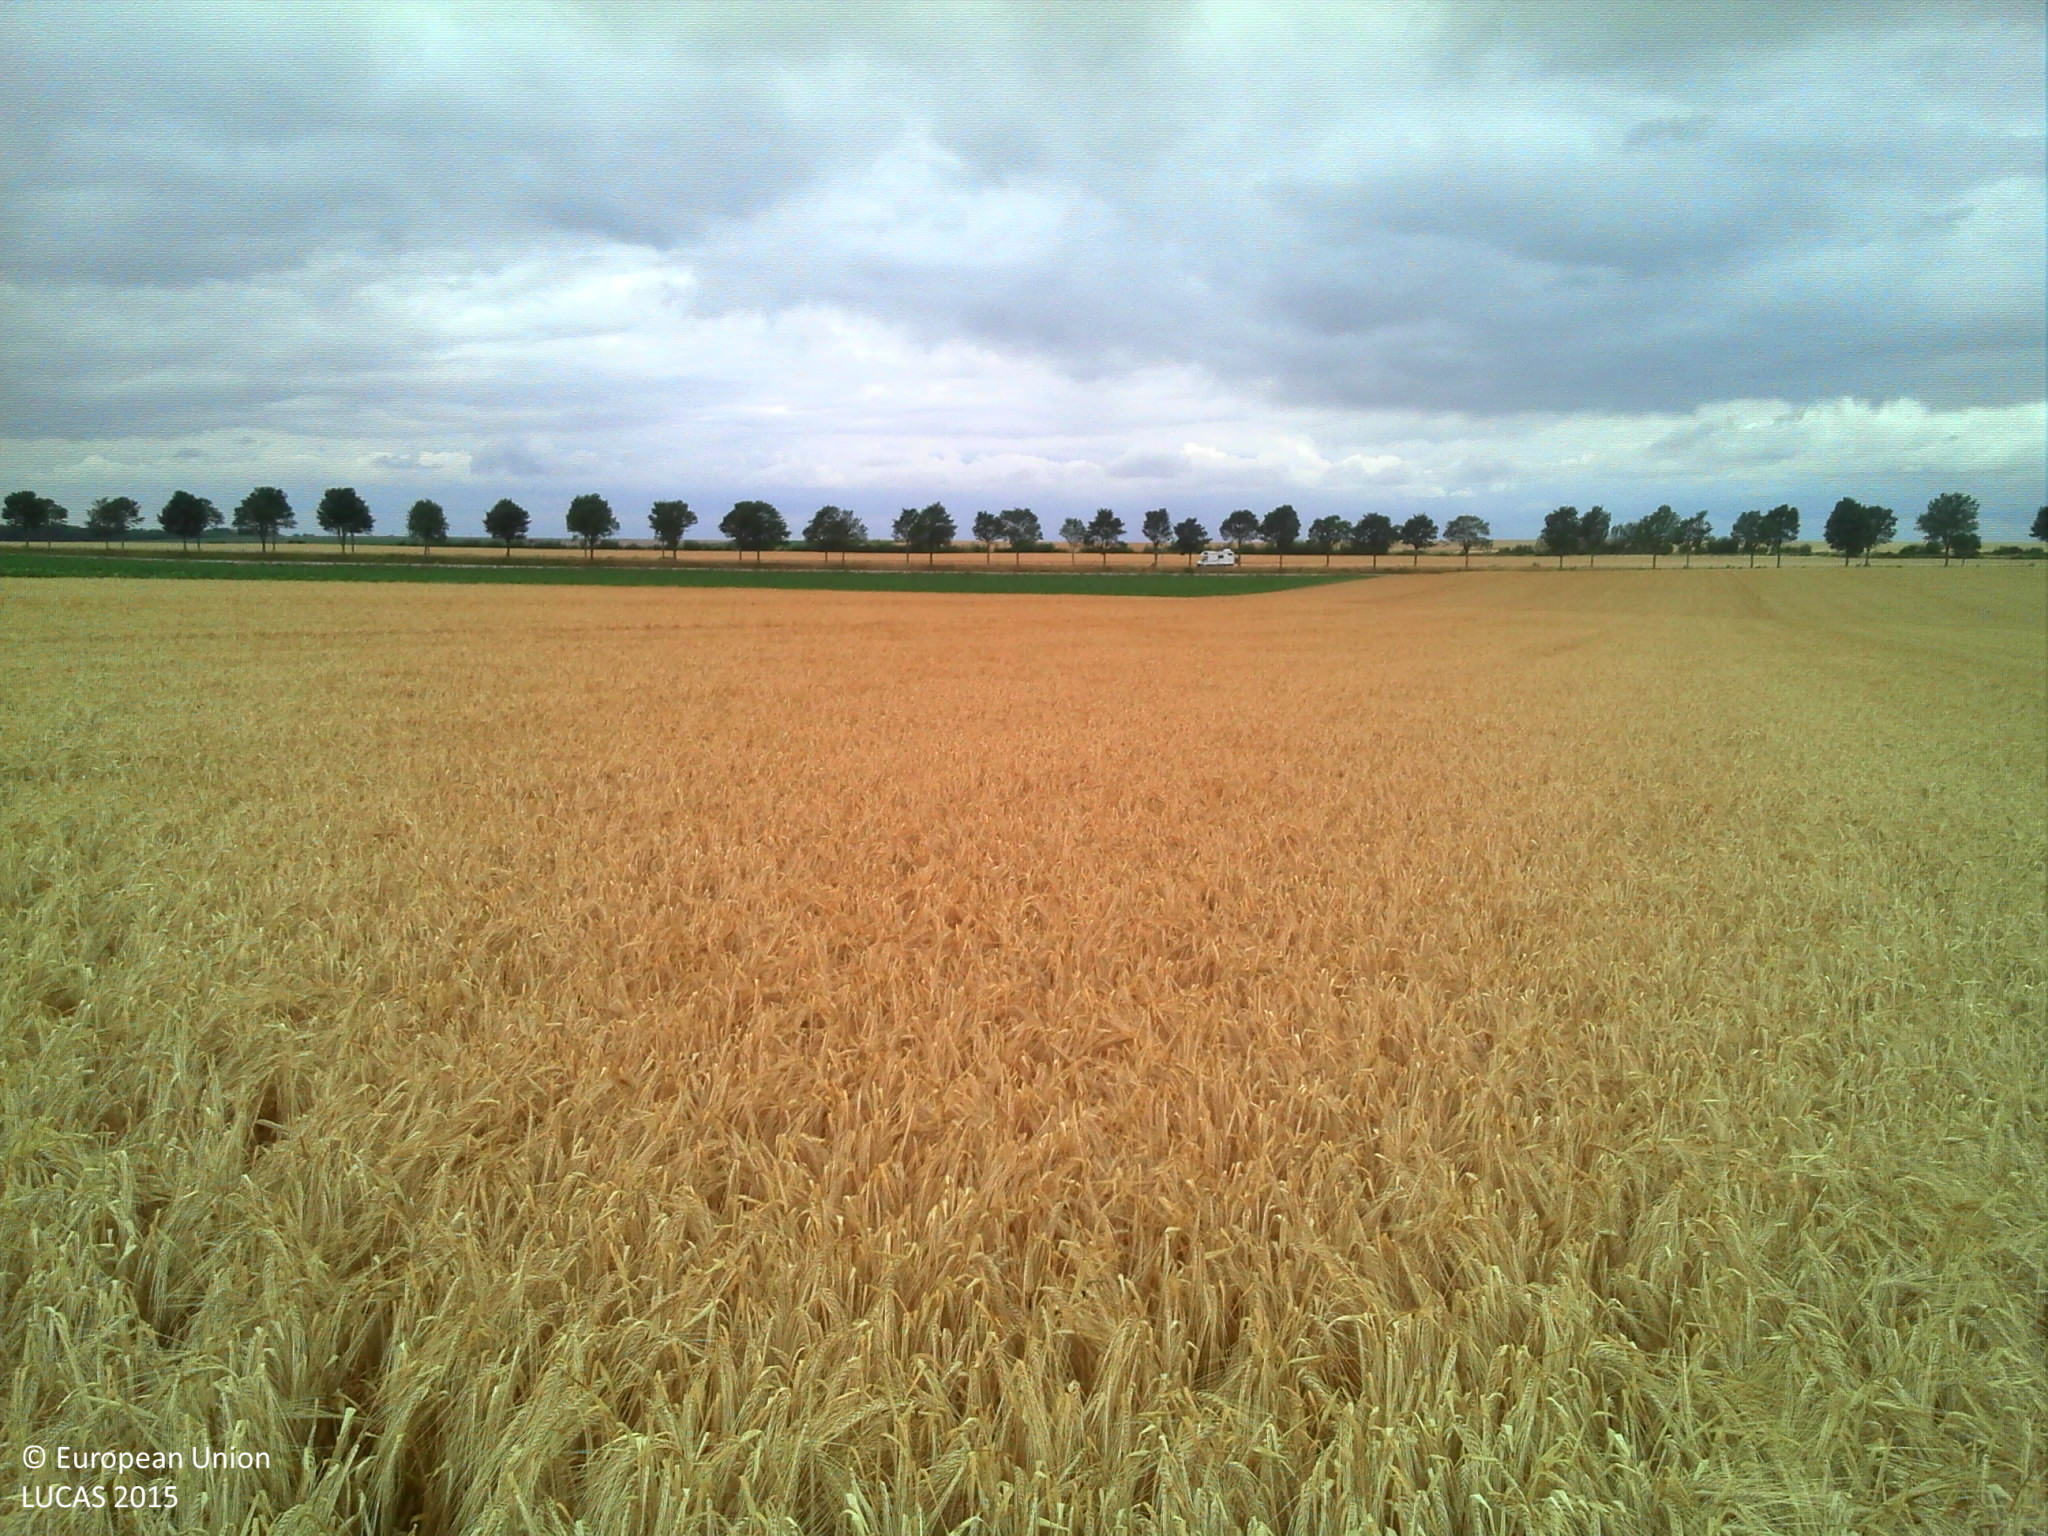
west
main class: Cropland
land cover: Barley
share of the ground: > 75 %
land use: Agriculture (excluding fallow land and kitchen gardens)
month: July
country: FR
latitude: 48.7571
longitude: 4.2149
